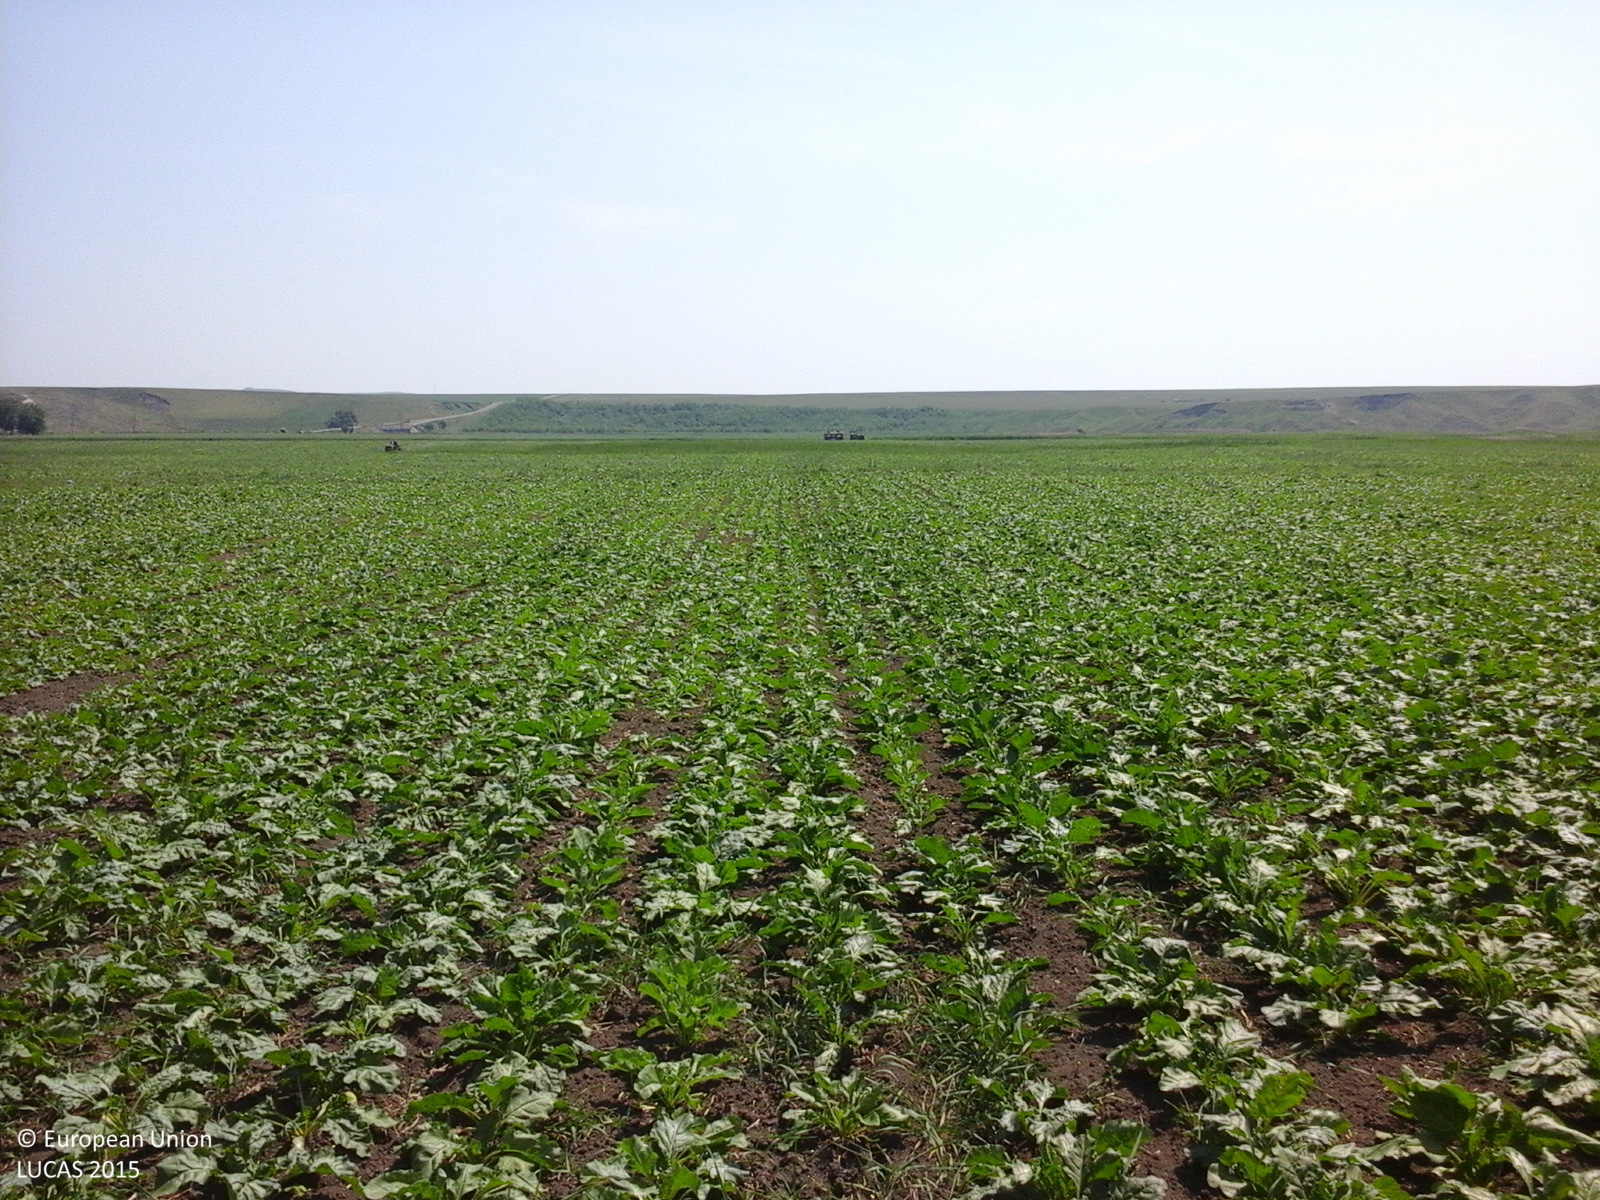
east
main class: Cropland
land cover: Other root crops
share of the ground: 50 - 75 %
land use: Agriculture (excluding fallow land and kitchen gardens)
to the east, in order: Other root crops; Spontaneously vegetated surfaces
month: June
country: RO
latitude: 46.8905
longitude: 26.5305
